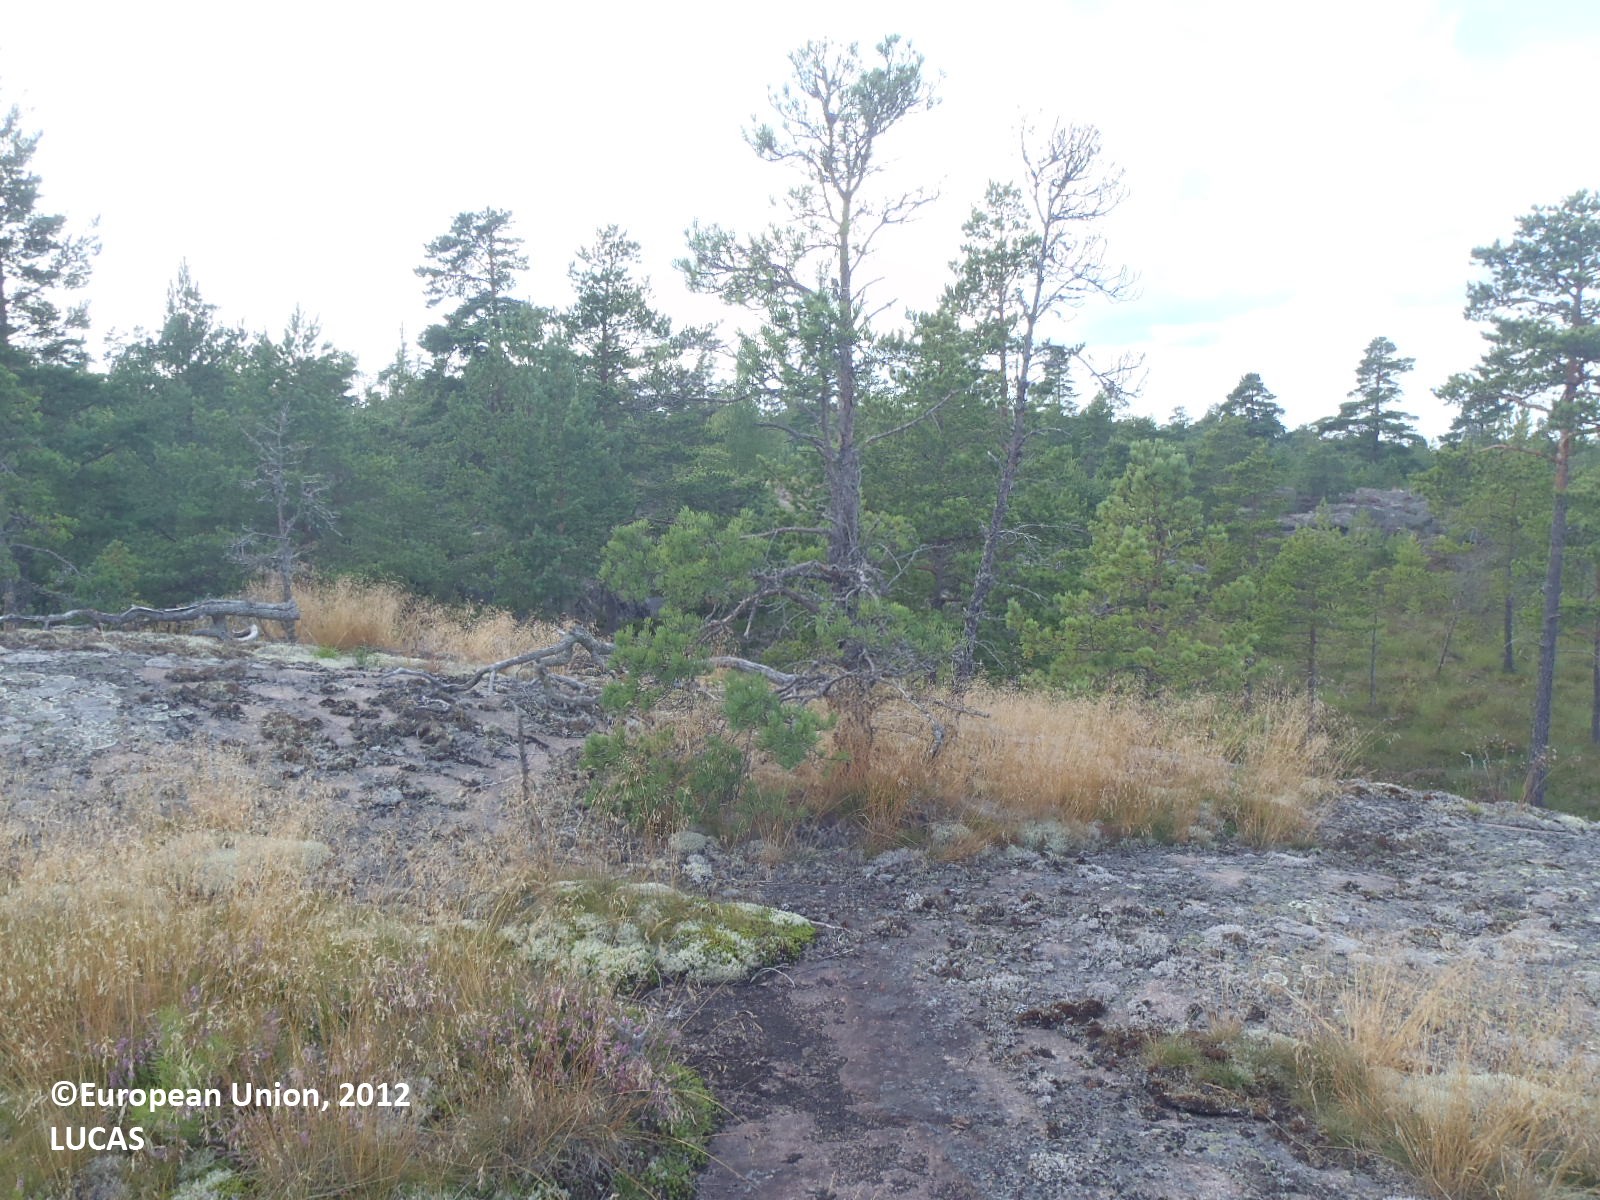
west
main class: Woodland
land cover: Pine dominated coniferous woodland
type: boreal forest
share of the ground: 10 - 25 %
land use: Semi-natural and natural areas not in use
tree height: > 5 m
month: August
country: FI
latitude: 60.3467
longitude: 20.3191
